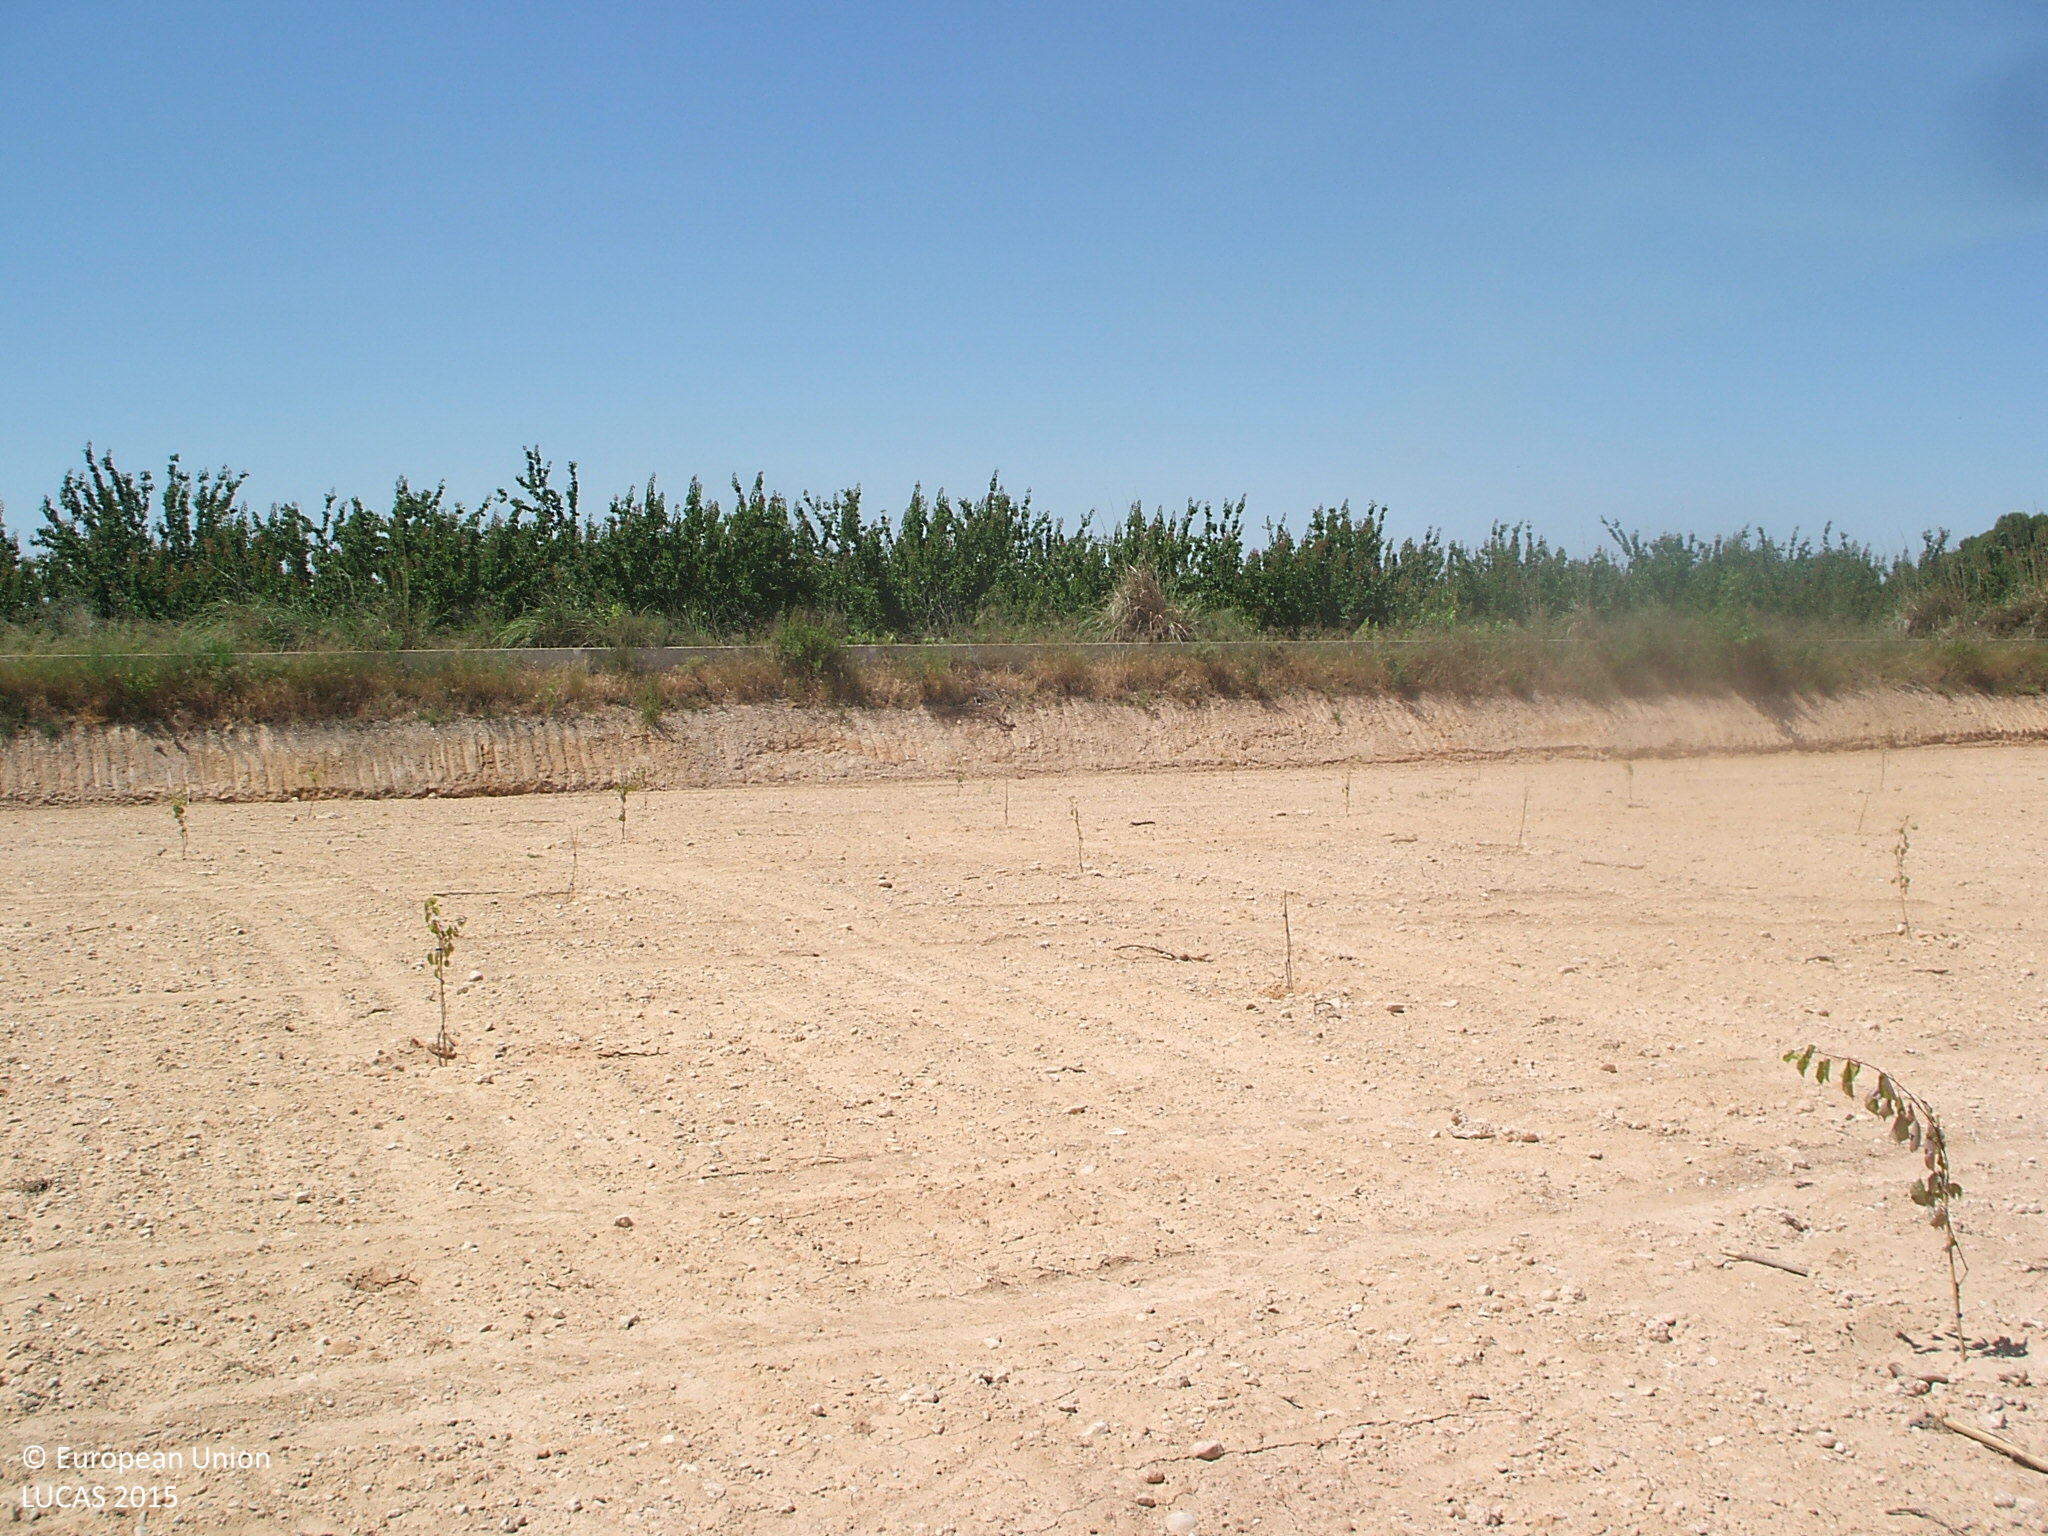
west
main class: Cropland
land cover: Nuts trees
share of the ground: < 10 %
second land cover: Other bare soil
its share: > 75 %
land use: Agriculture (excluding fallow land and kitchen gardens)
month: June
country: ES
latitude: 41.1119
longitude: -0.2661
